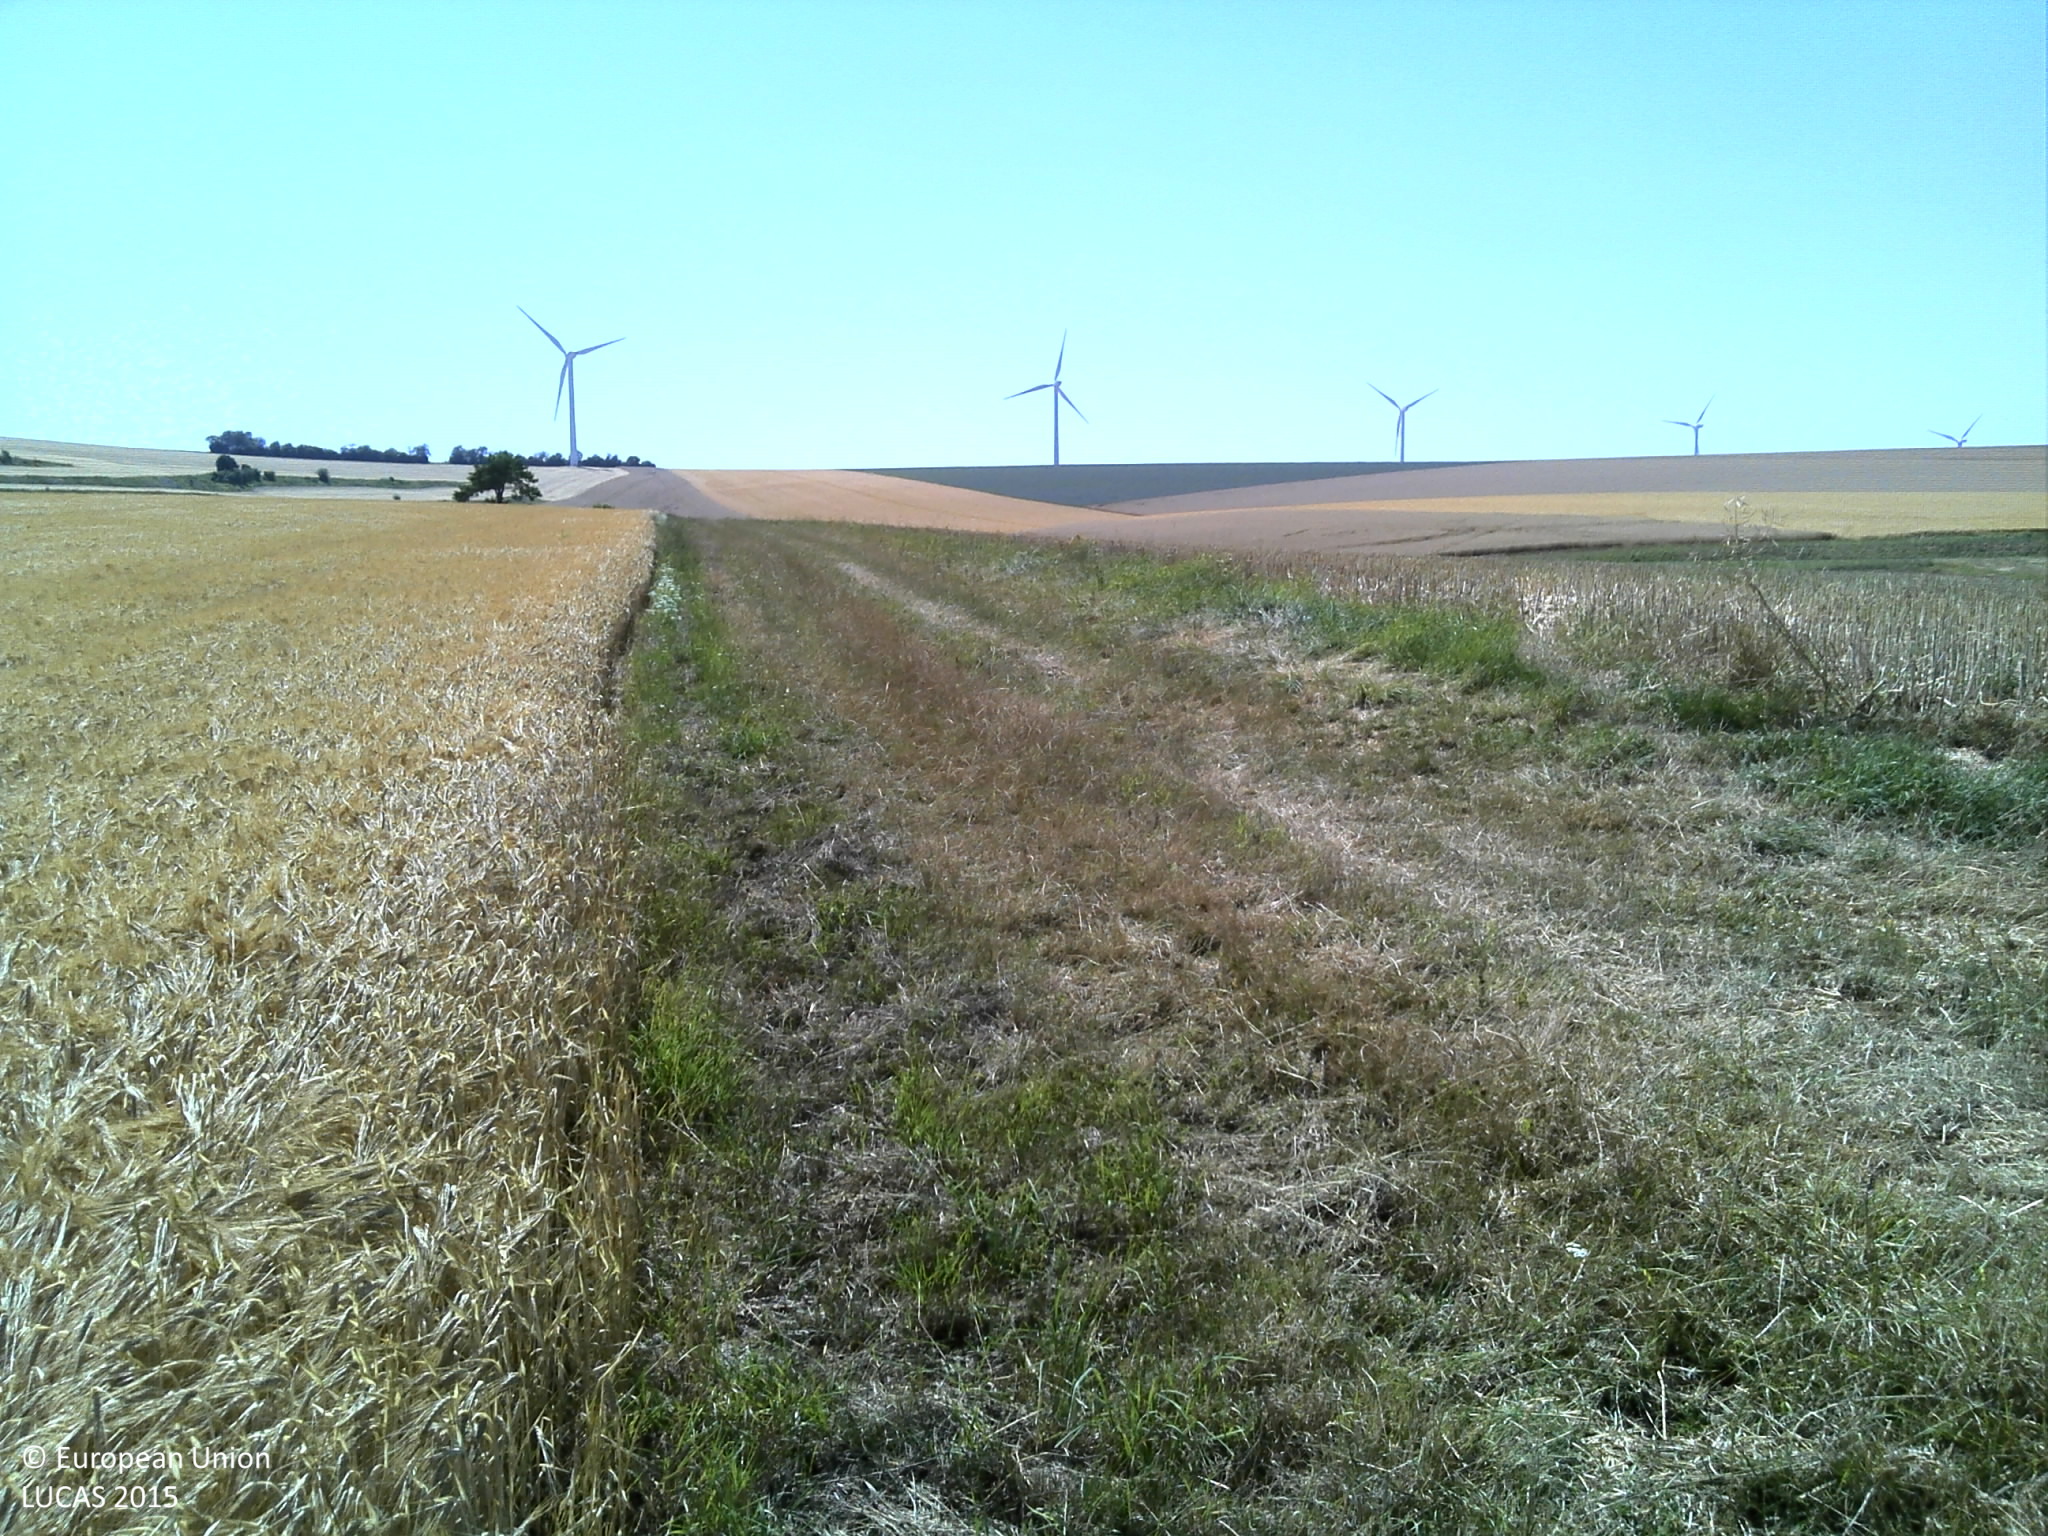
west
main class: Cropland
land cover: Barley
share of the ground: > 75 %
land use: Agriculture (excluding fallow land and kitchen gardens)
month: July
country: FR
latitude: 48.8685
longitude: 4.6394
